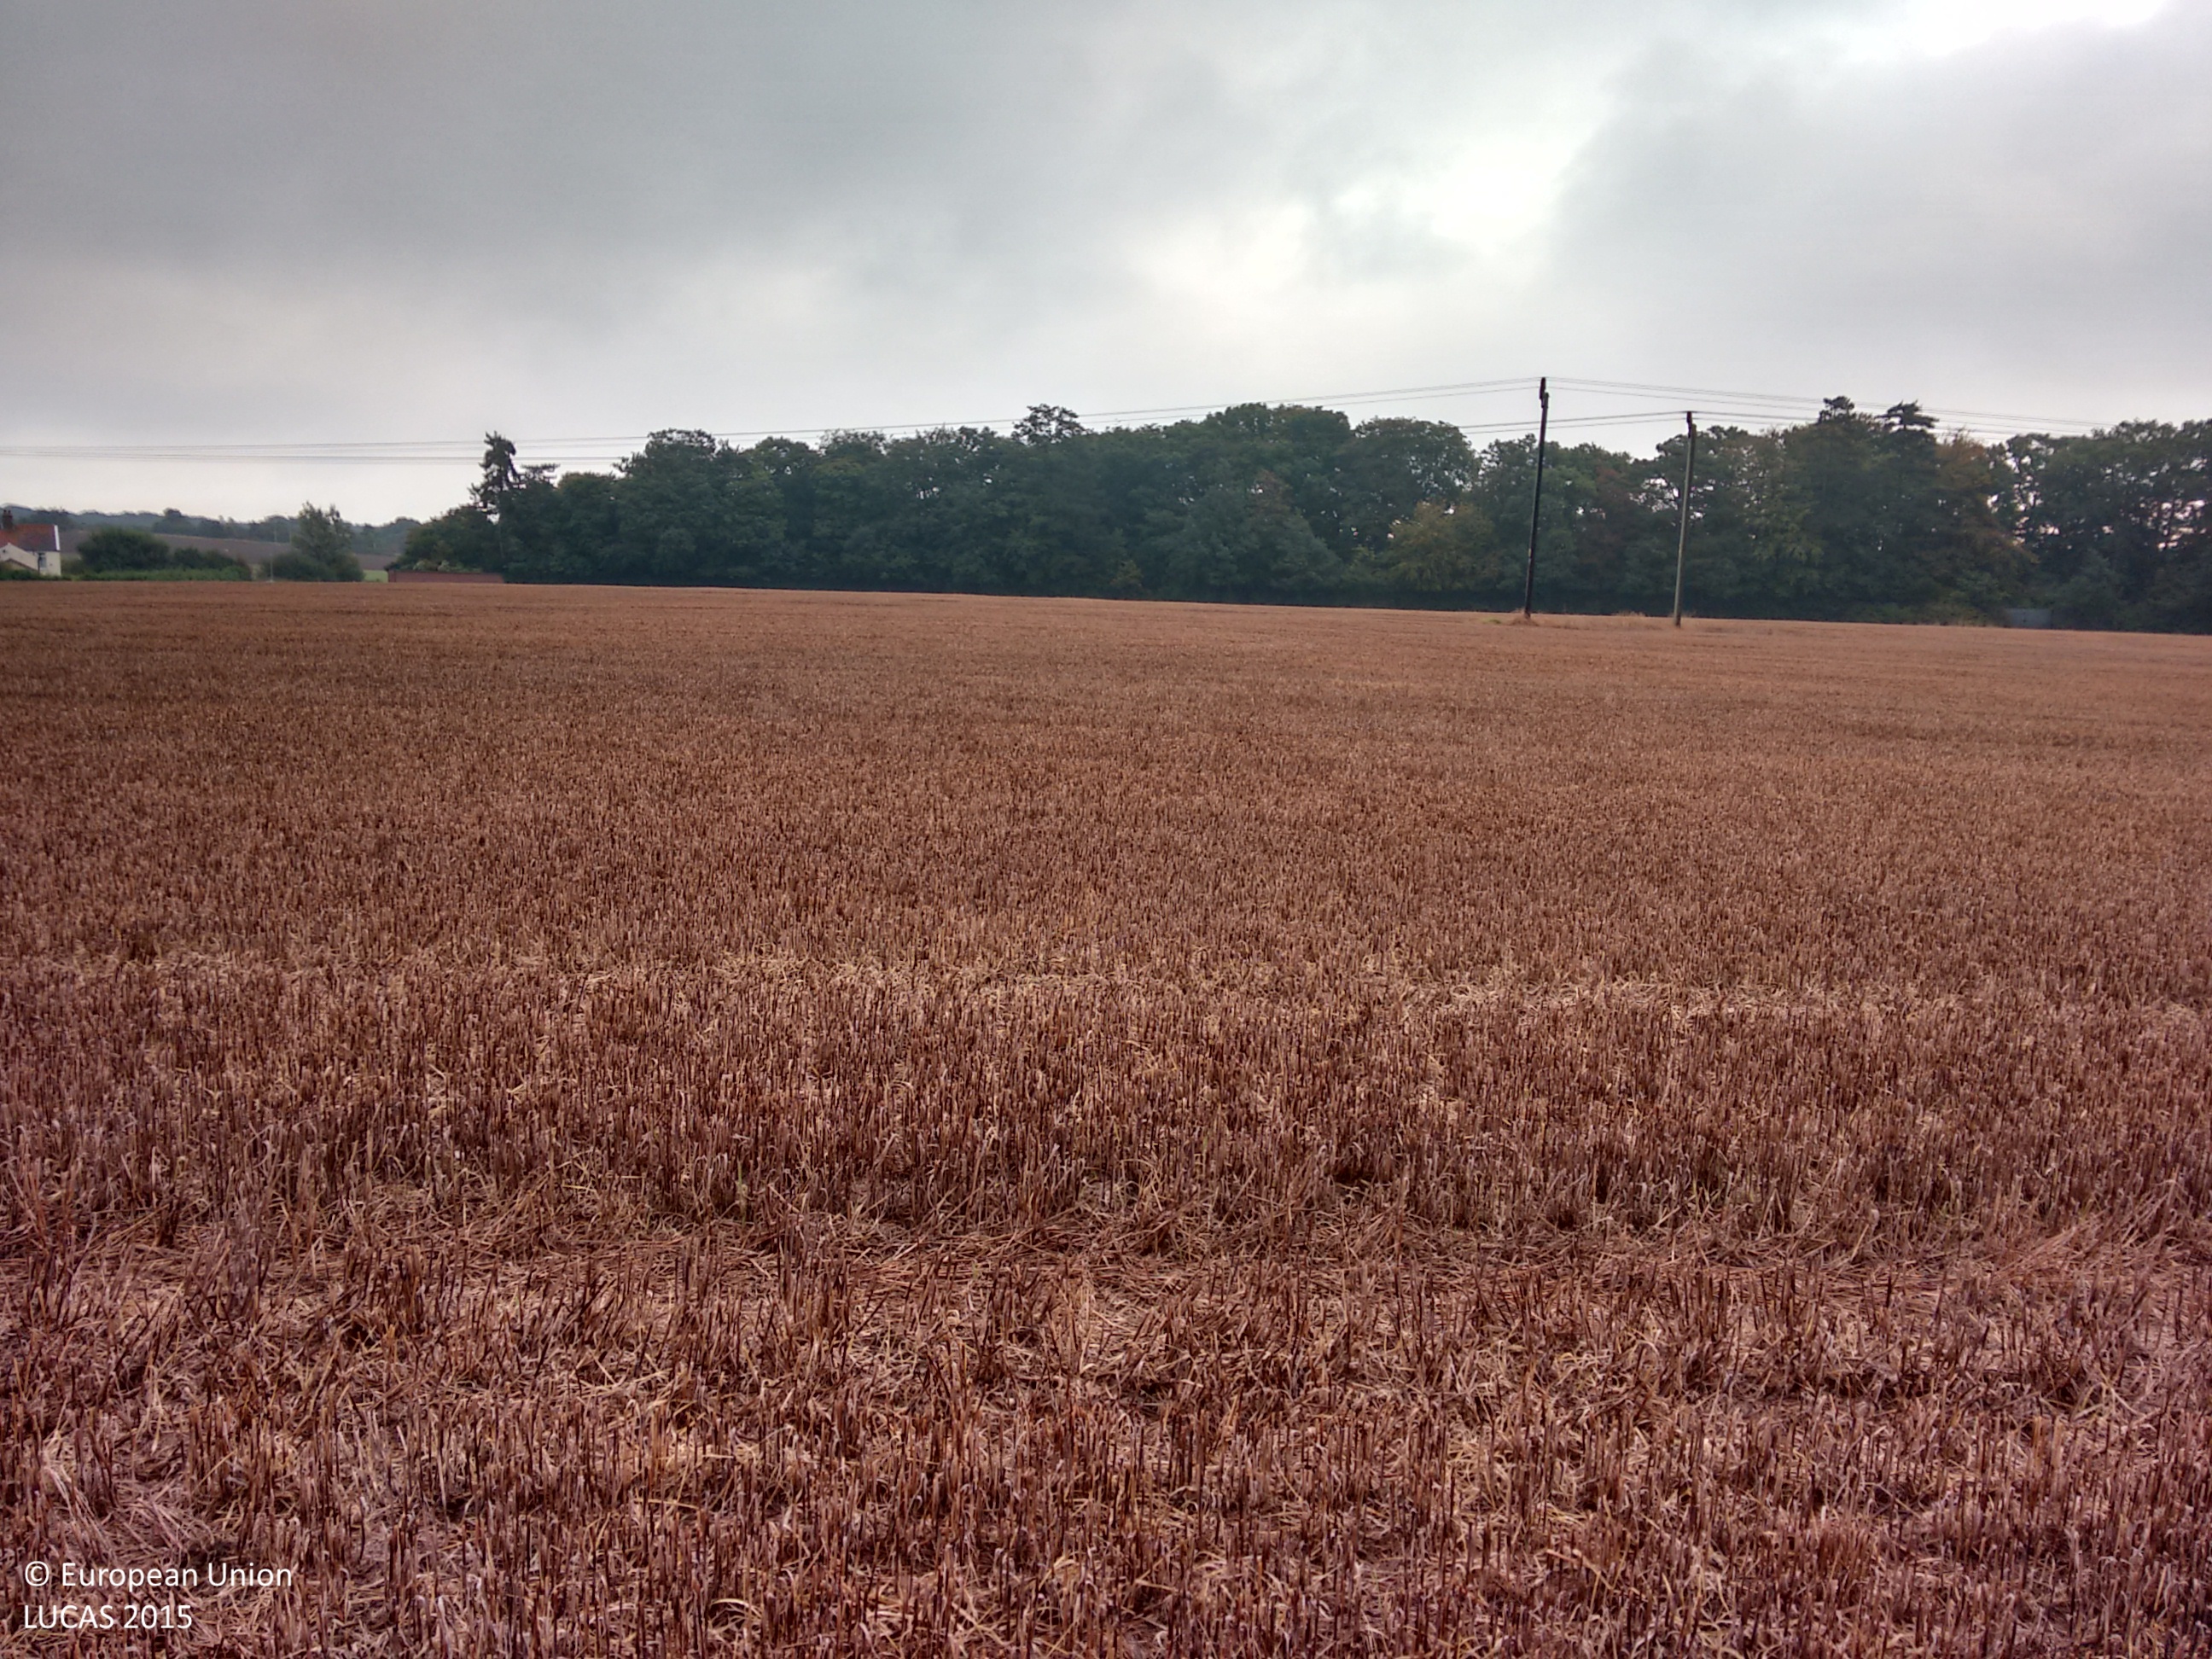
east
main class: Cropland
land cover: Common wheat
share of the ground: > 75 %
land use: Agriculture (excluding fallow land and kitchen gardens)
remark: Harvested field
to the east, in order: Common wheat; Electric lines; Common wheat; Electric lines; Common wheat; Grass margins; Paved roads, cycling and walking lanes; Grass margins; Managed hedges; Fences; Other mixed woodland
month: October
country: GB
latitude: 52.5391
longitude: 1.7112
